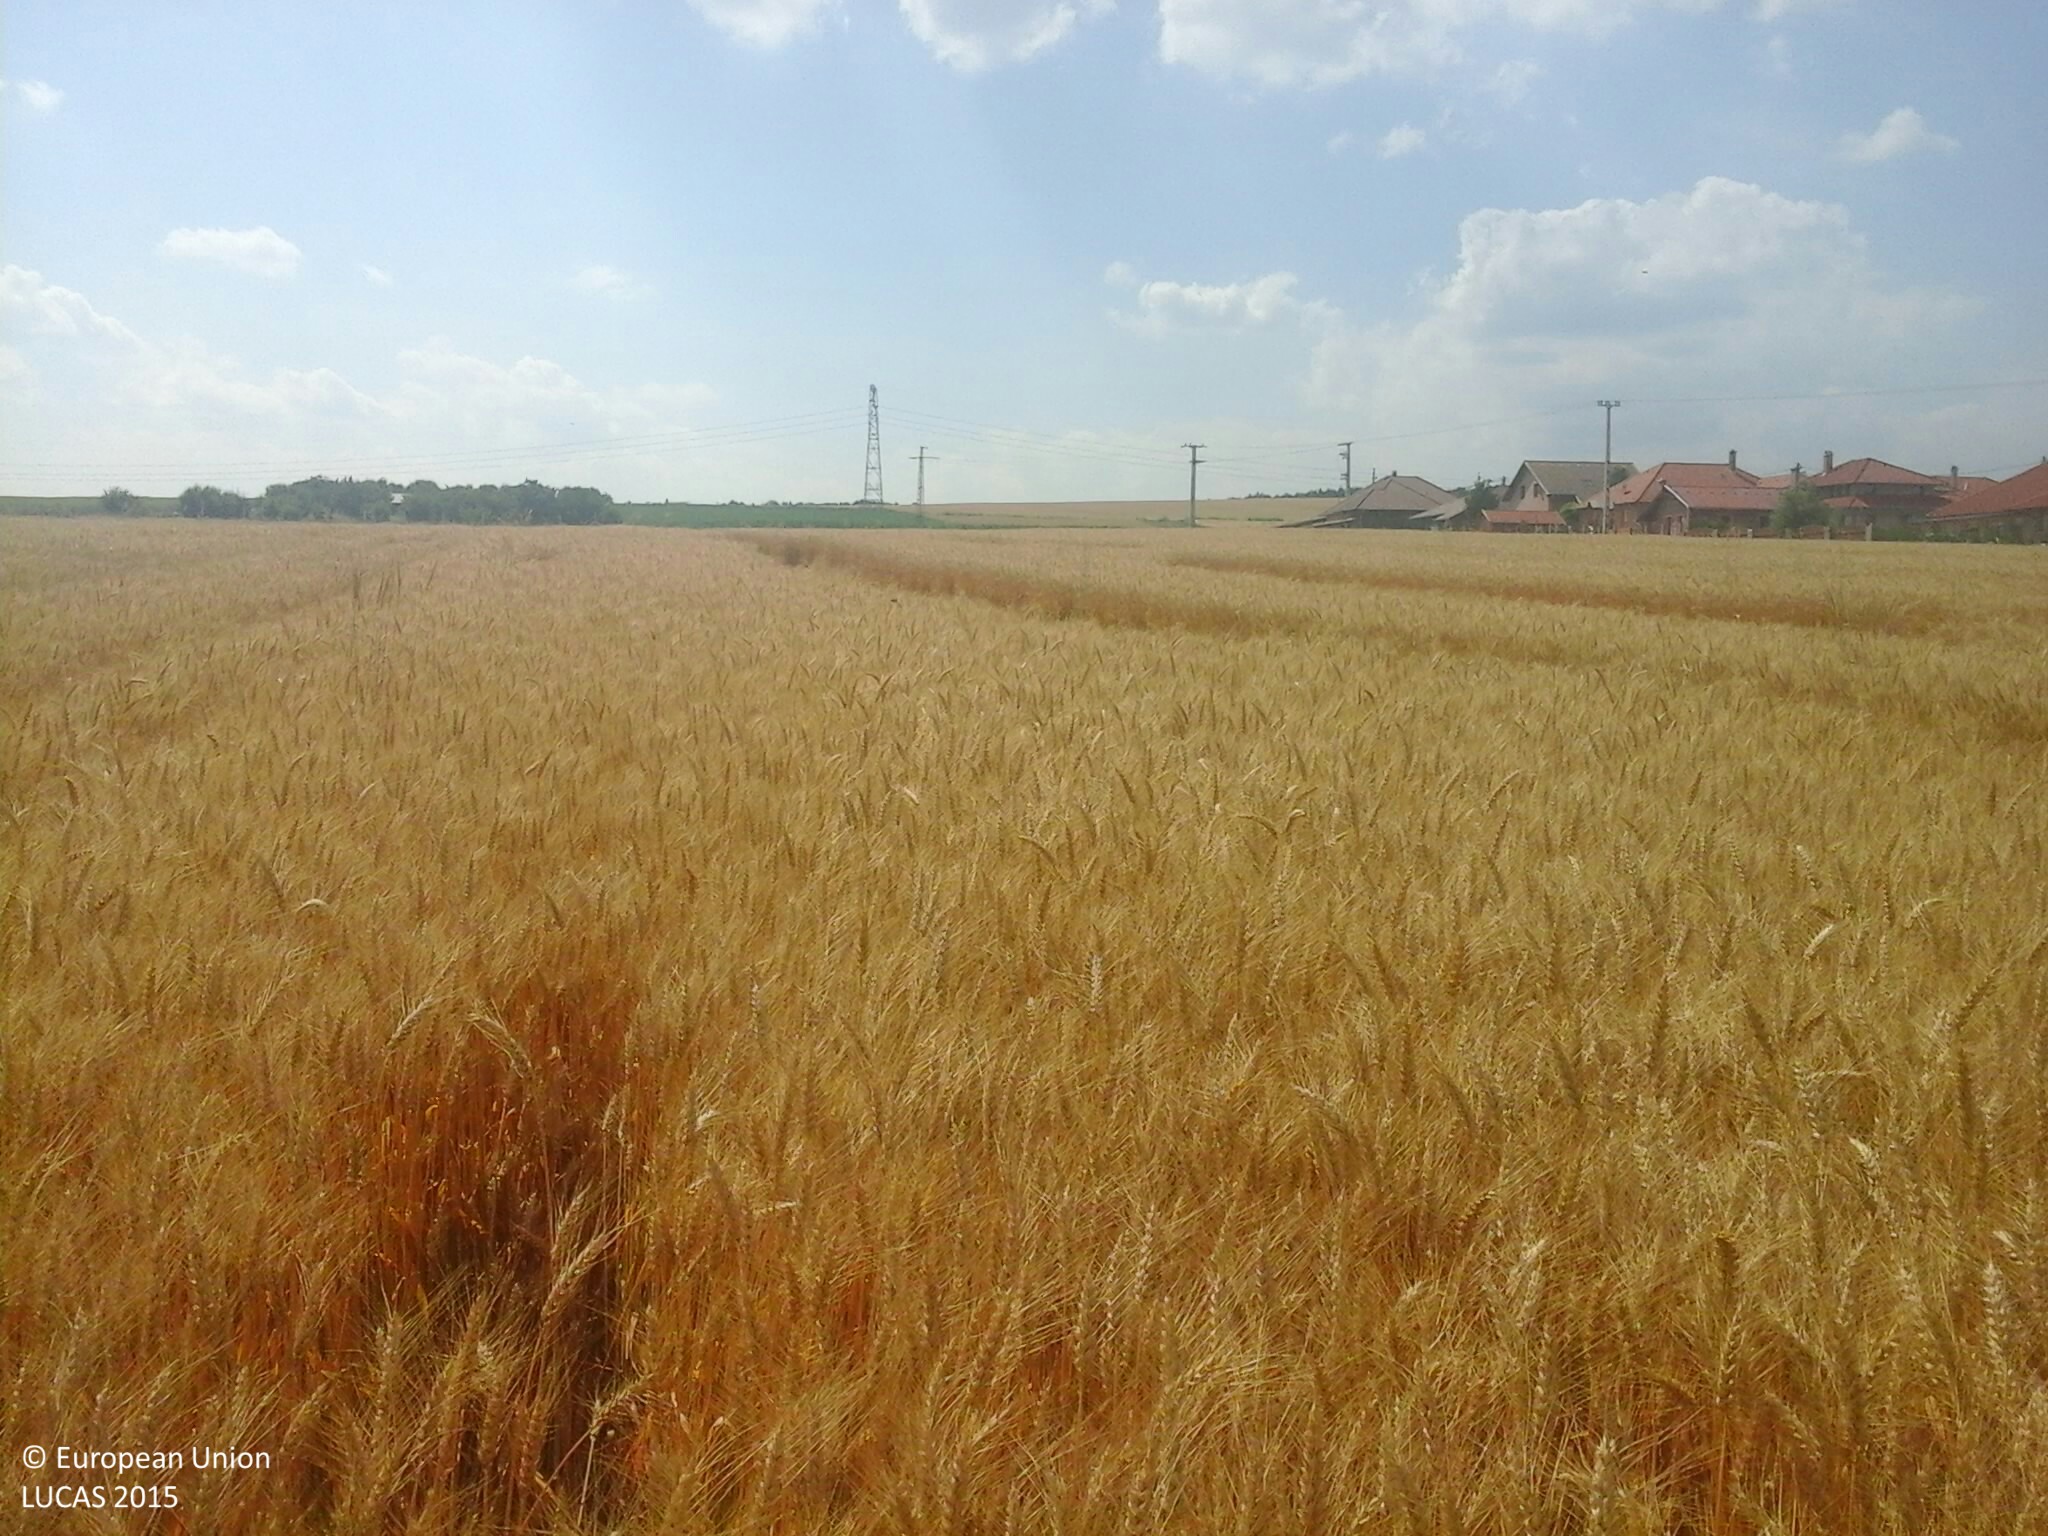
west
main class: Cropland
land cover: Common wheat
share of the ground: > 75 %
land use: Agriculture (excluding fallow land and kitchen gardens)
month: July
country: HU
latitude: 47.7825
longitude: 19.2160
